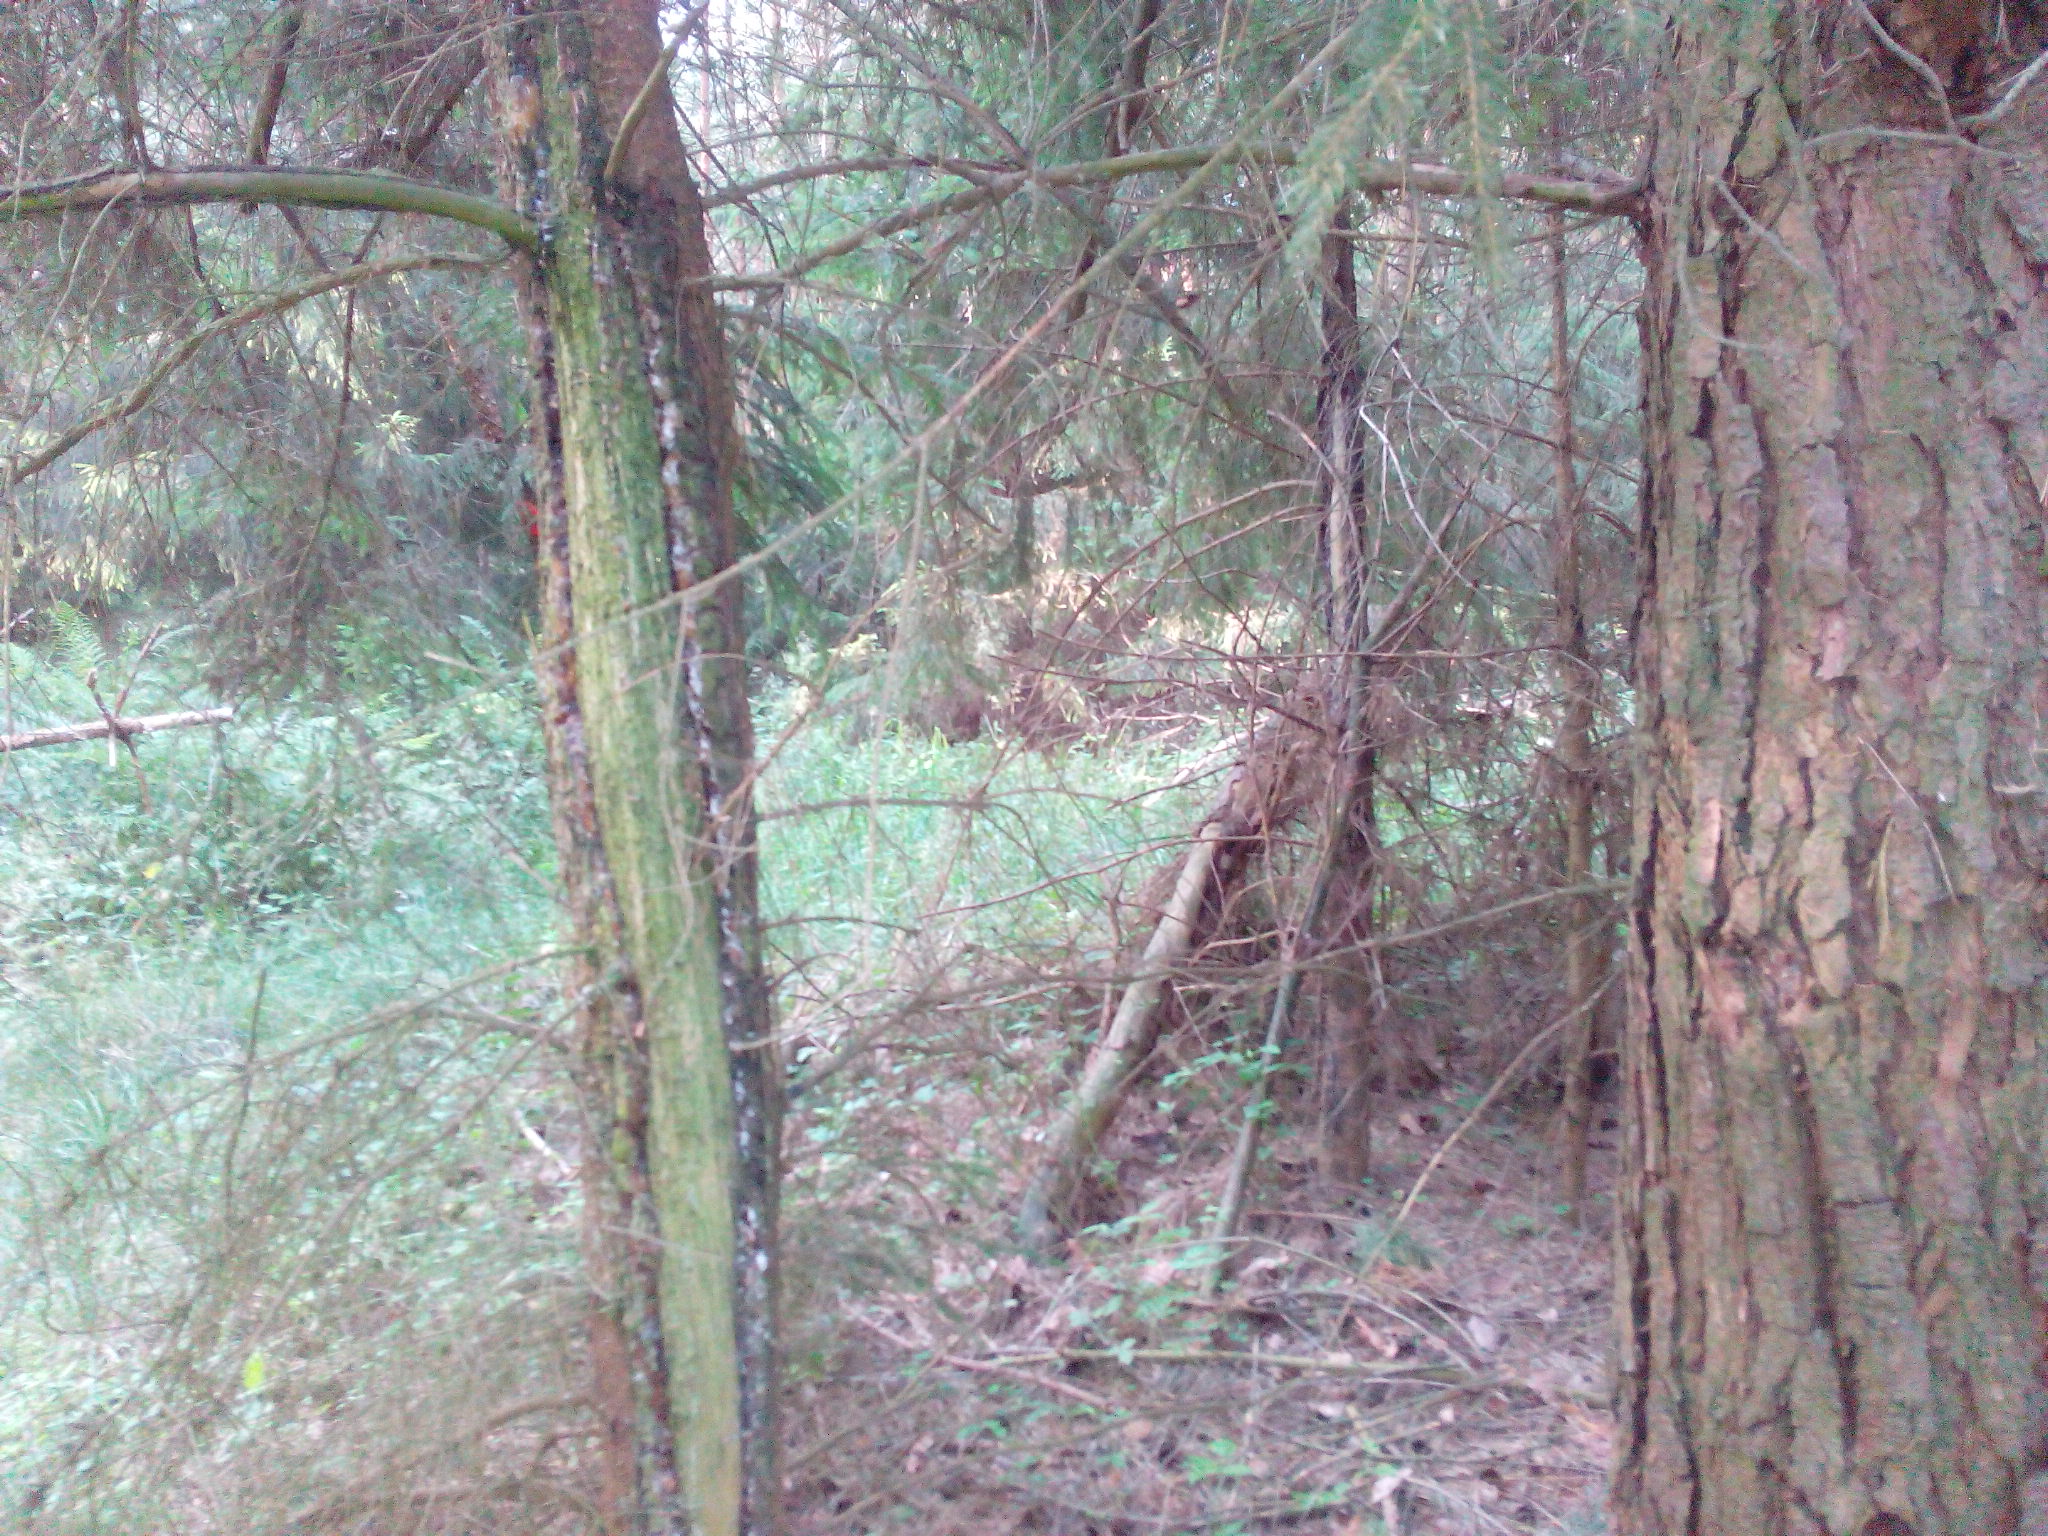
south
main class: Woodland
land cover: Spruce dominated coniferous woodland
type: hemiboreal forest and nemoral coniferous forest and mixed broadleaved-coniferous forest
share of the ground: > 75 %
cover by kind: coniferous forest trees 75 %, herbaceous plants 25 %
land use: Forestry
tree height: > 5 m
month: August
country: DE
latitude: 52.5931
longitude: 9.8967
